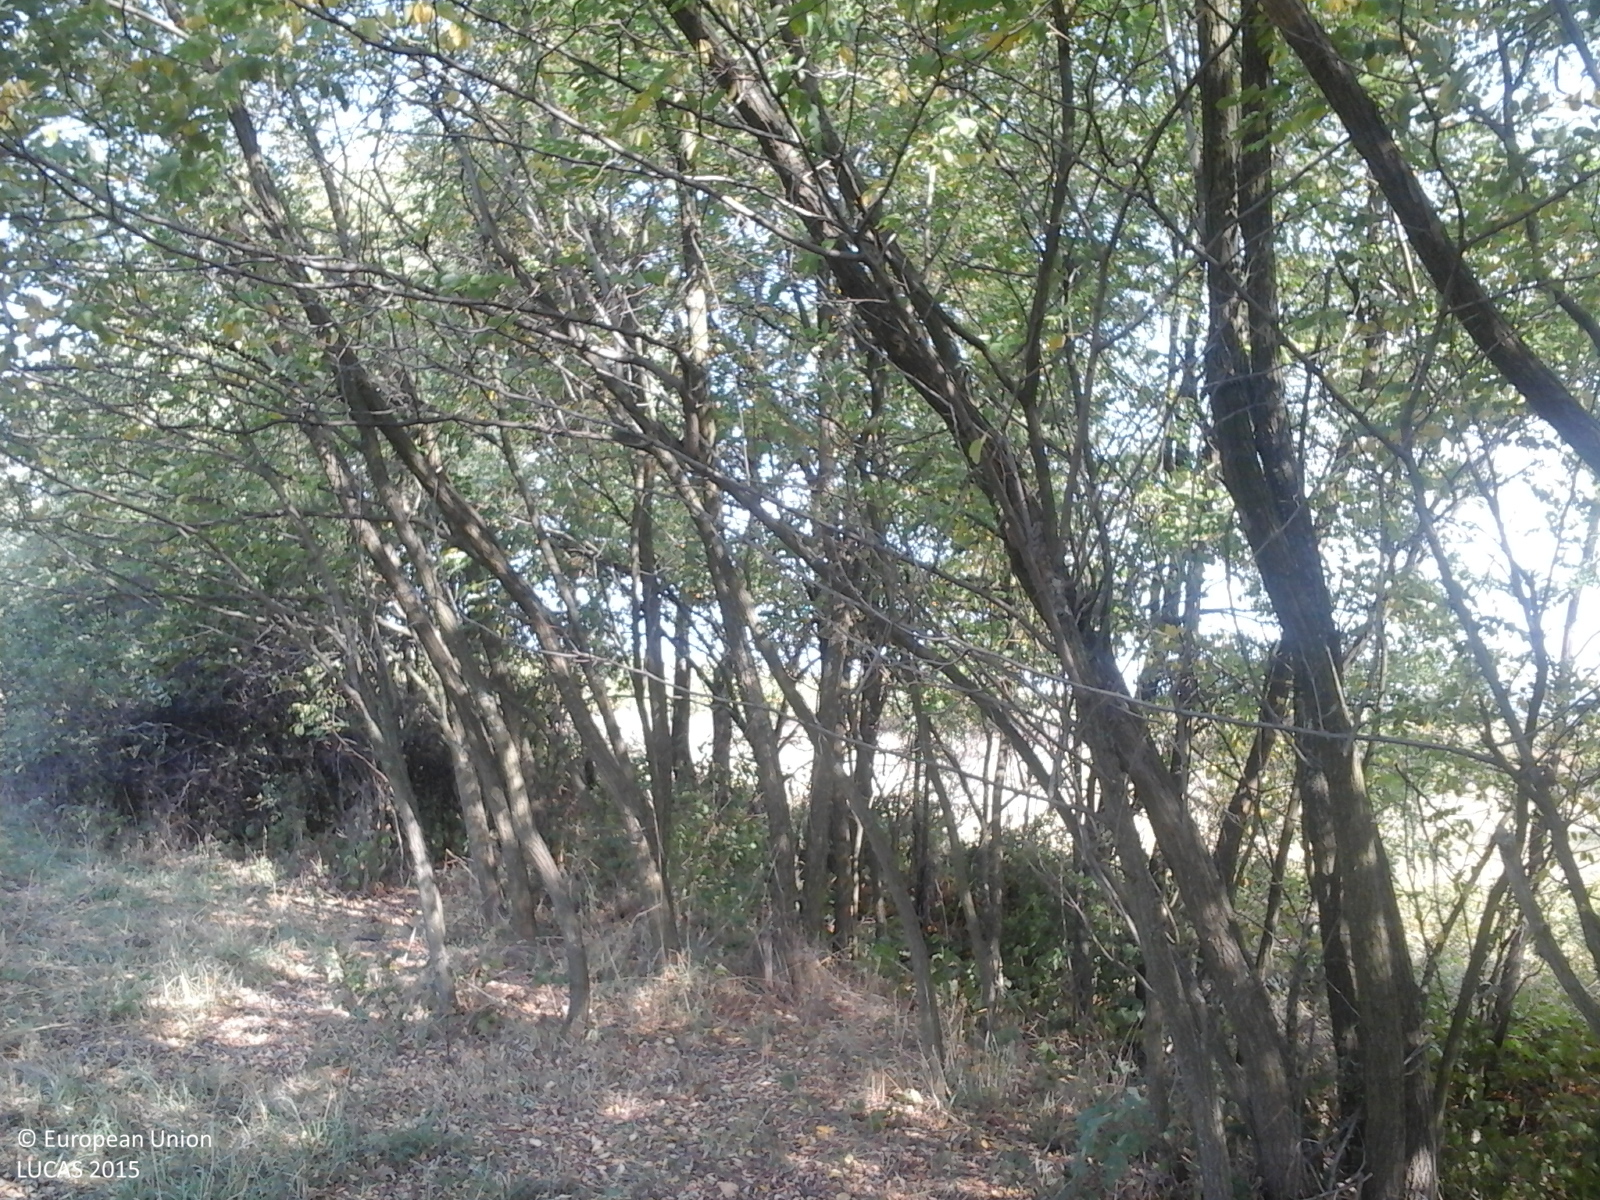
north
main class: Grassland
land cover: Grassland with sparse tree/shrub cover
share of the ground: > 75 %
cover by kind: herbaceous plants 85 %, shrubs 10 %, broadleaved forest trees 5 %
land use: Agriculture (excluding fallow land and kitchen gardens)
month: September
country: RO
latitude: 45.0739
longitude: 22.2973
